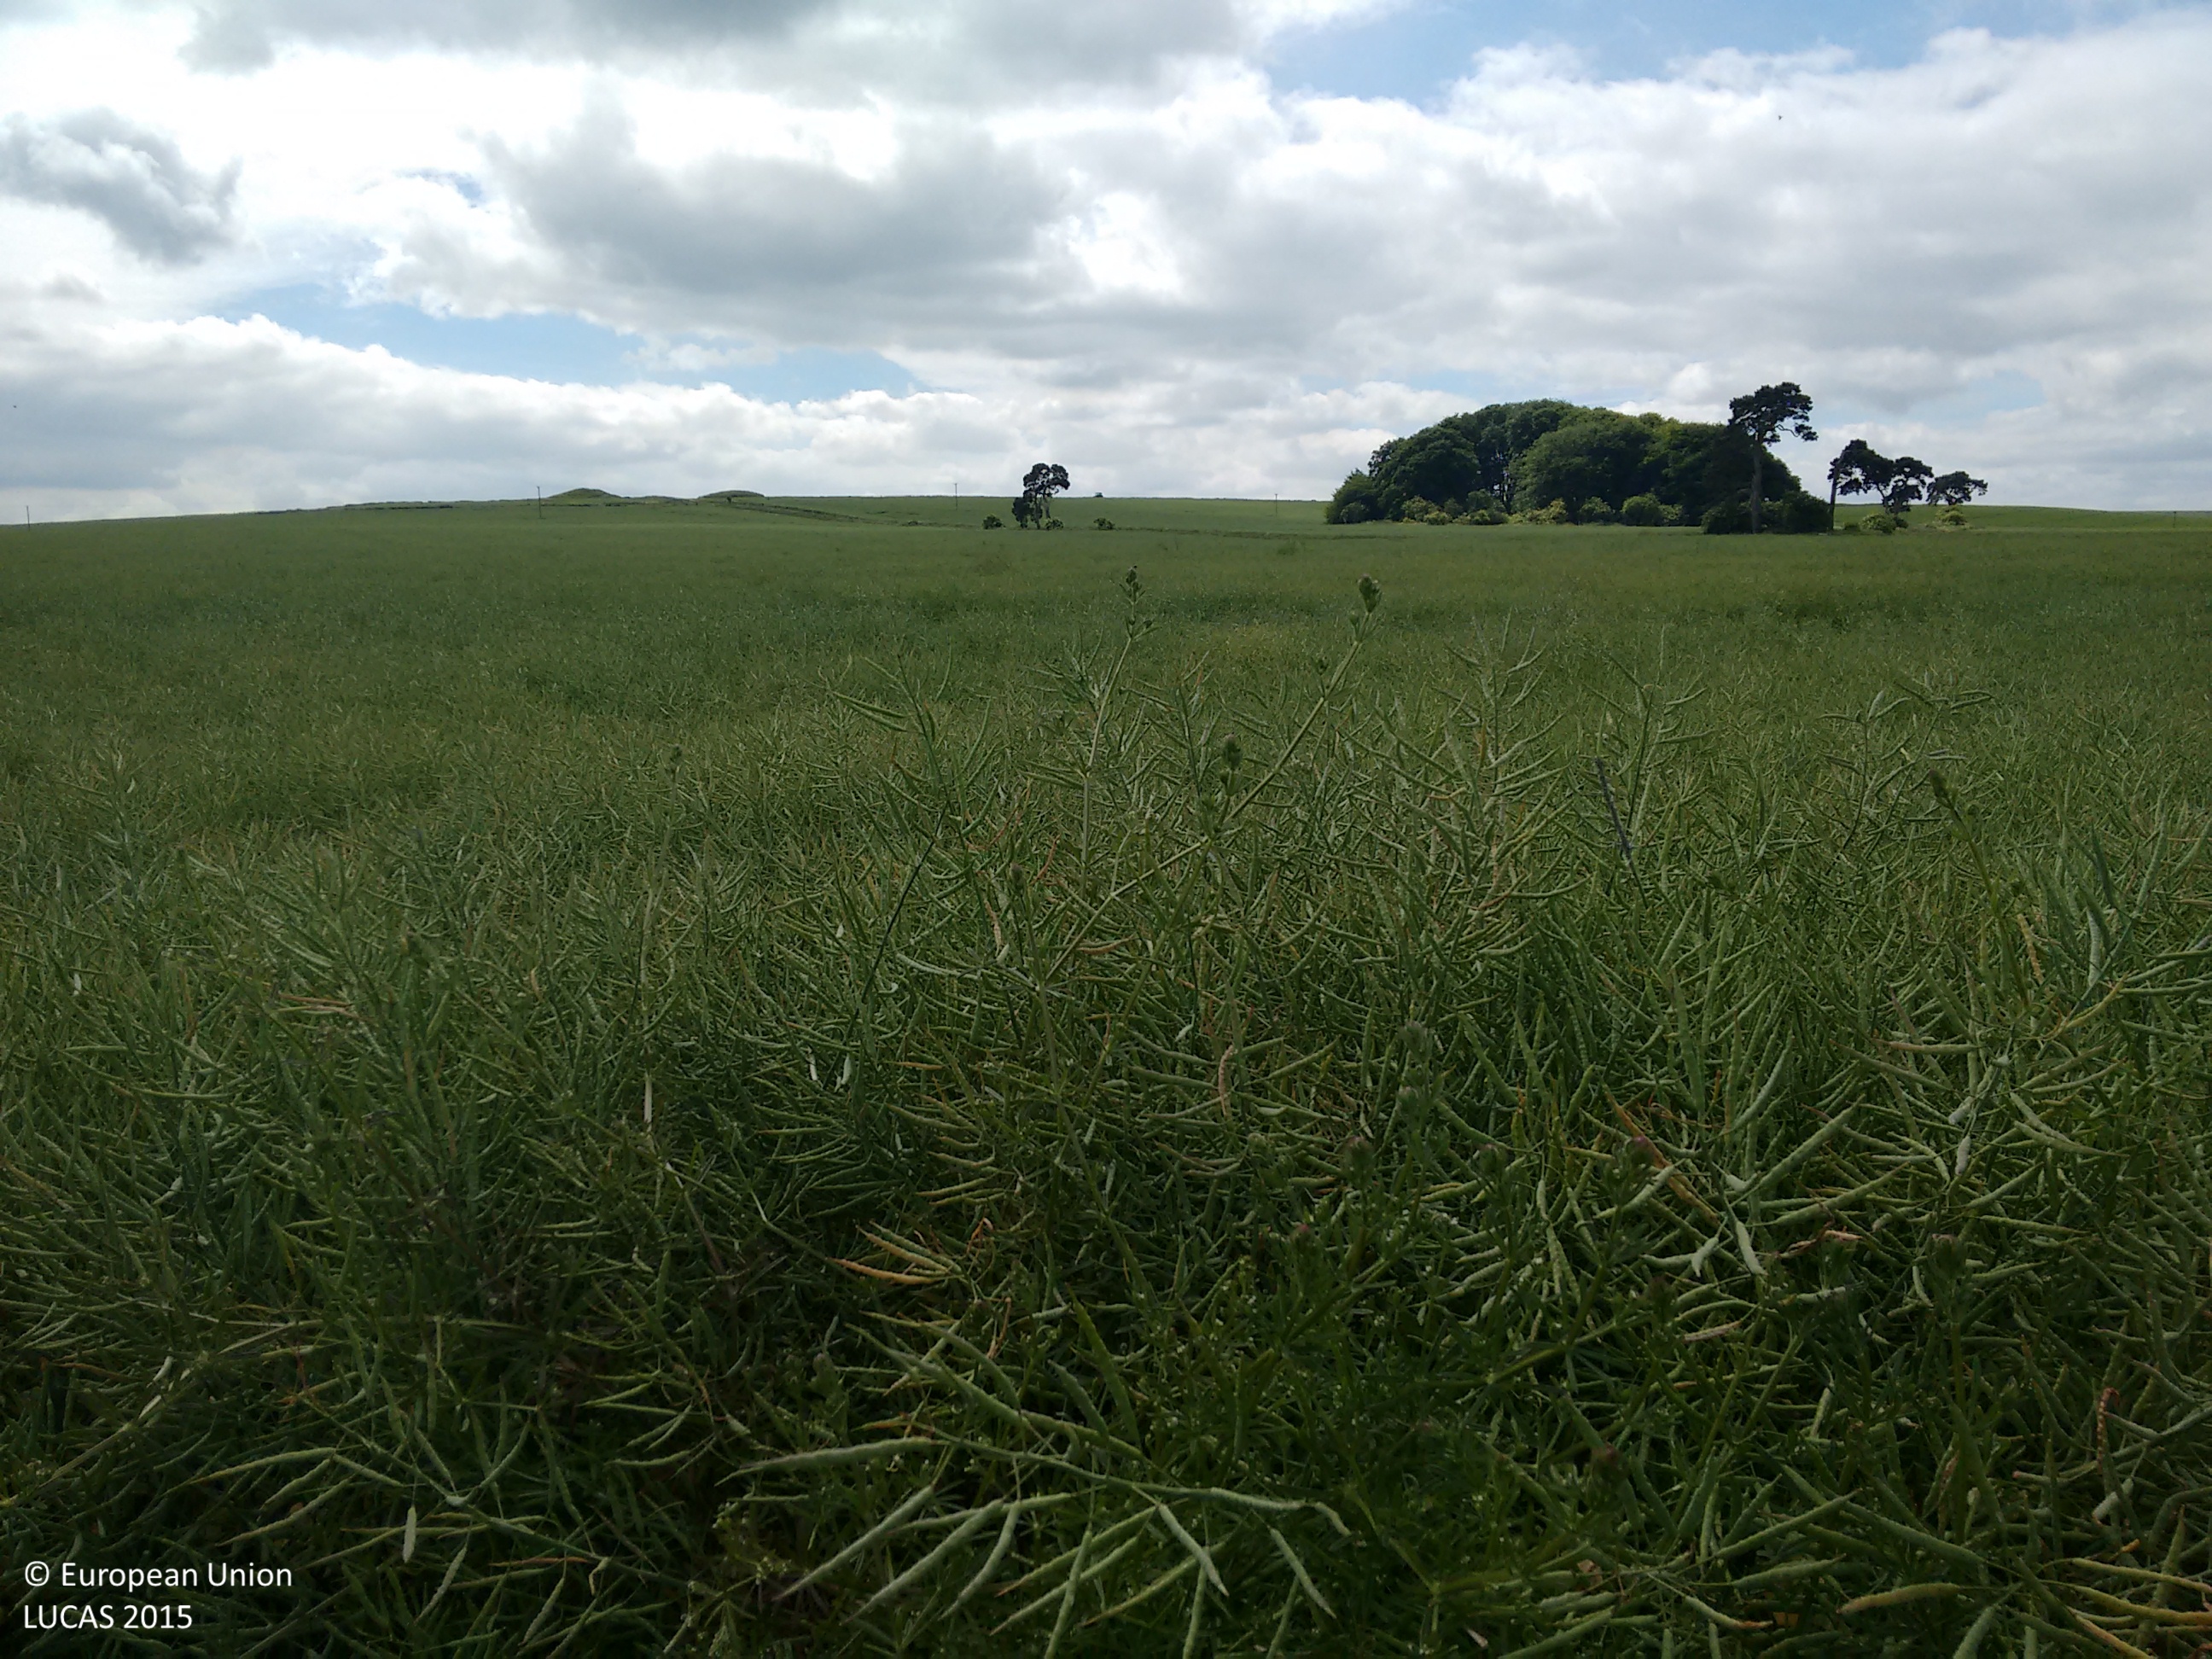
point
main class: Cropland
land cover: Rape and turnip rape
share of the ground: > 75 %
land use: Agriculture (excluding fallow land and kitchen gardens)
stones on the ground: 25 - 50 %
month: June
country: GB
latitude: 51.4138
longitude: -1.8902
